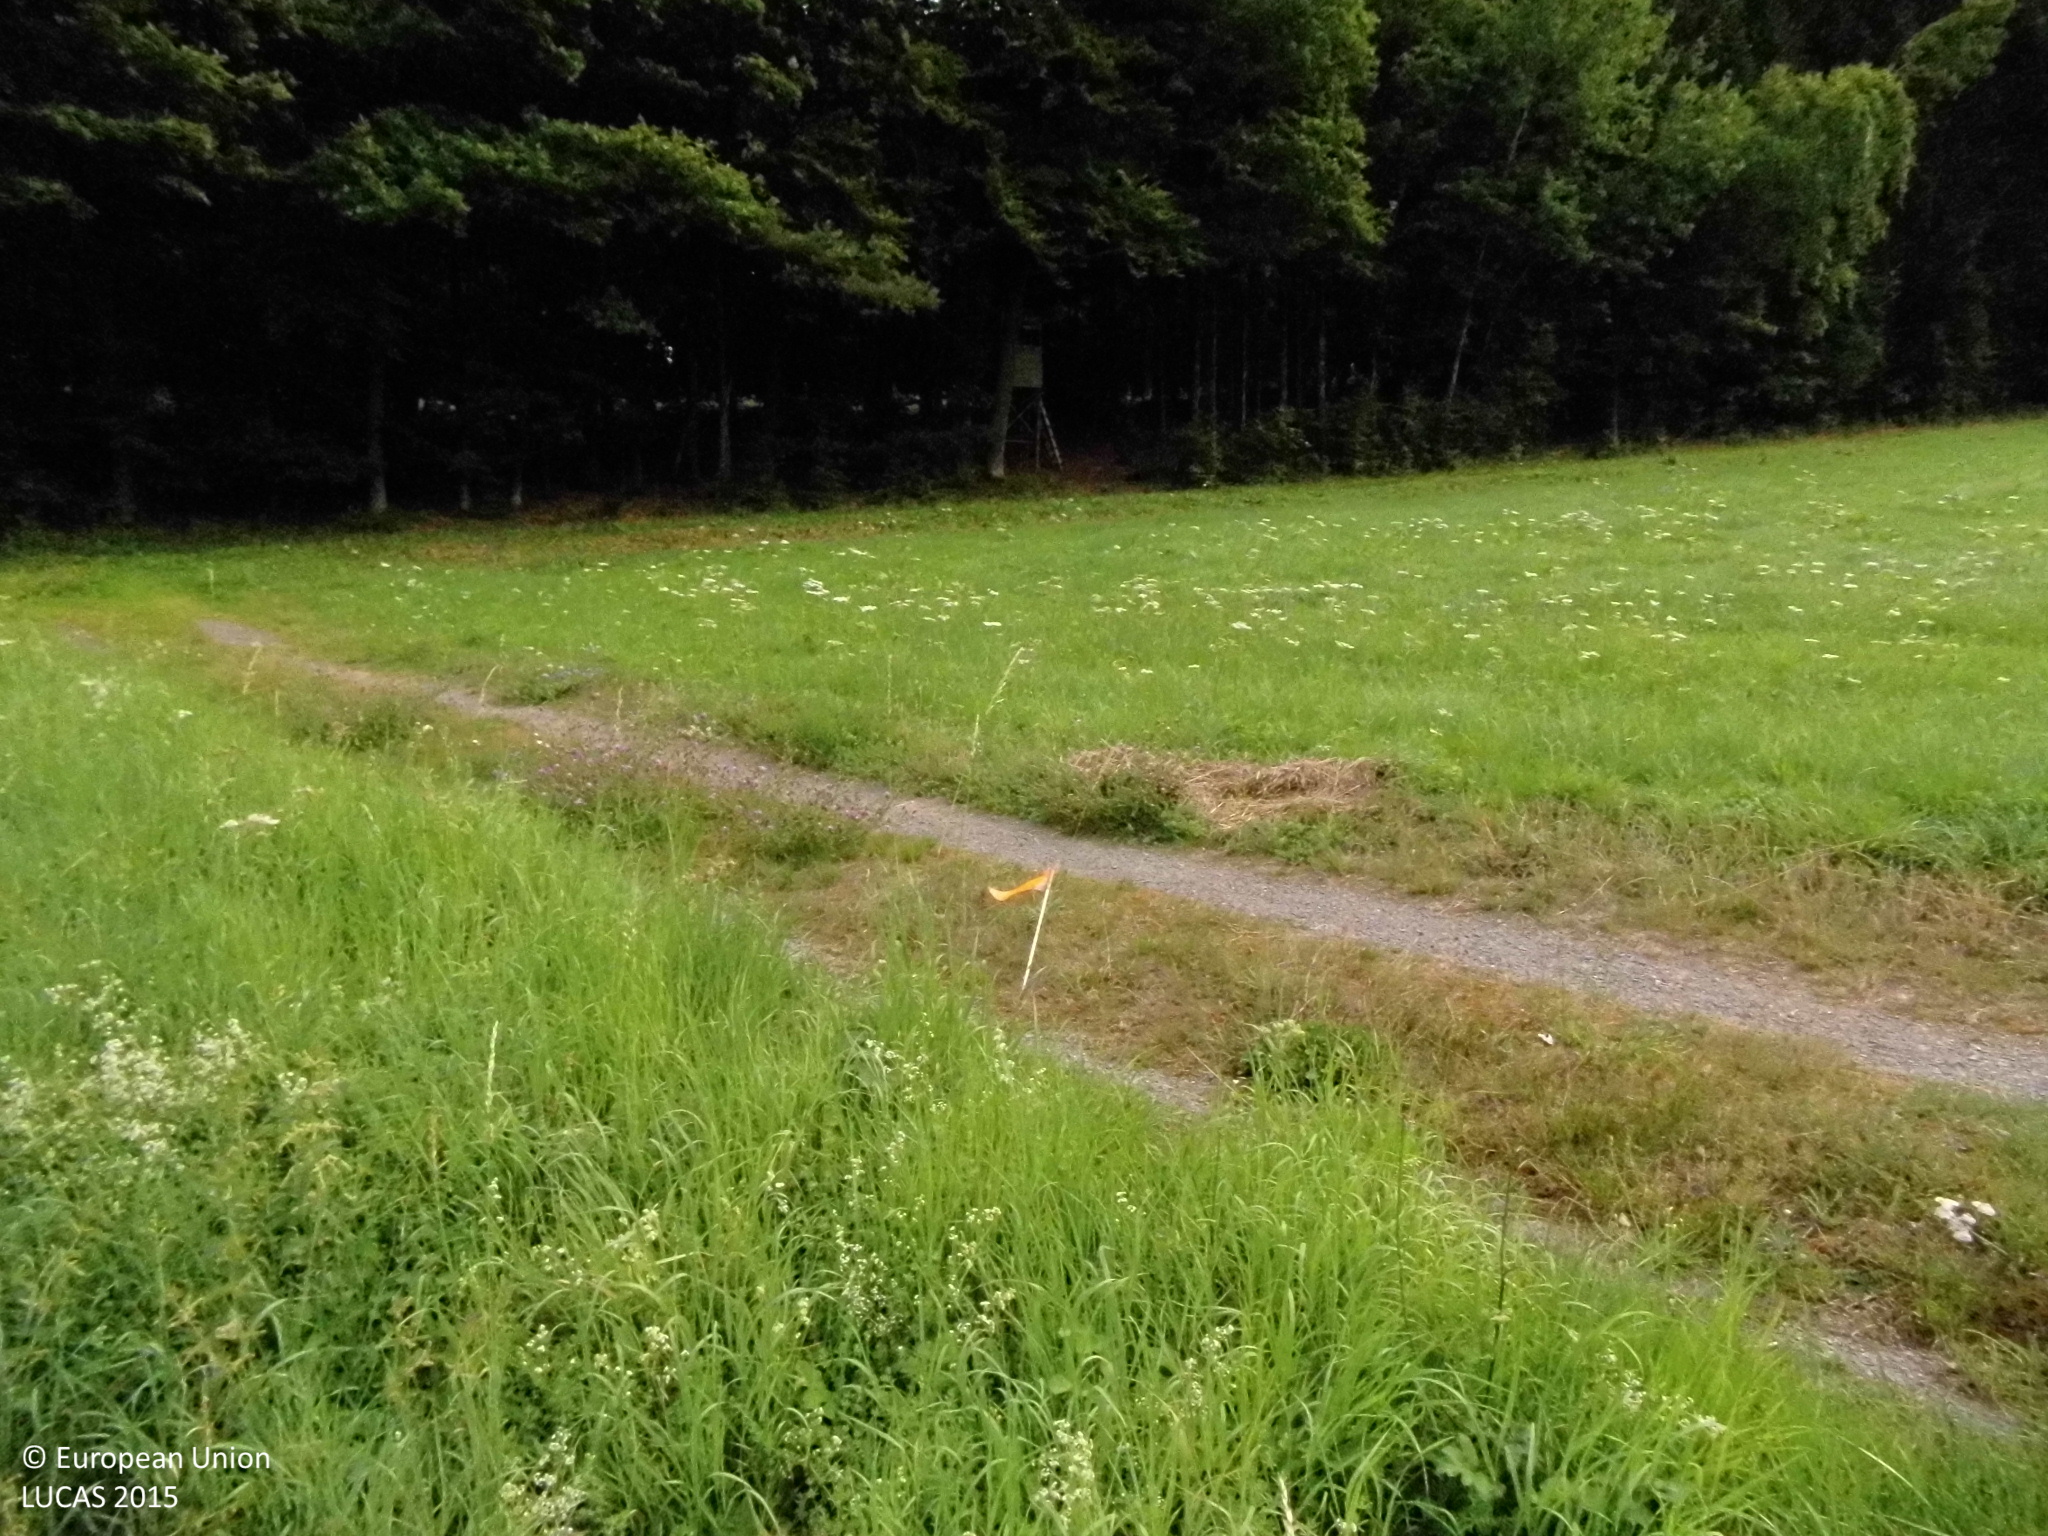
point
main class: Grassland
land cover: Grassland without tree/shrub cover
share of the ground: > 75 %
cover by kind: herbaceous plants 95 %, shrubs 5 %
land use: Agriculture (excluding fallow land and kitchen gardens)
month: August
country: DE
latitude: 50.7691
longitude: 8.5966
